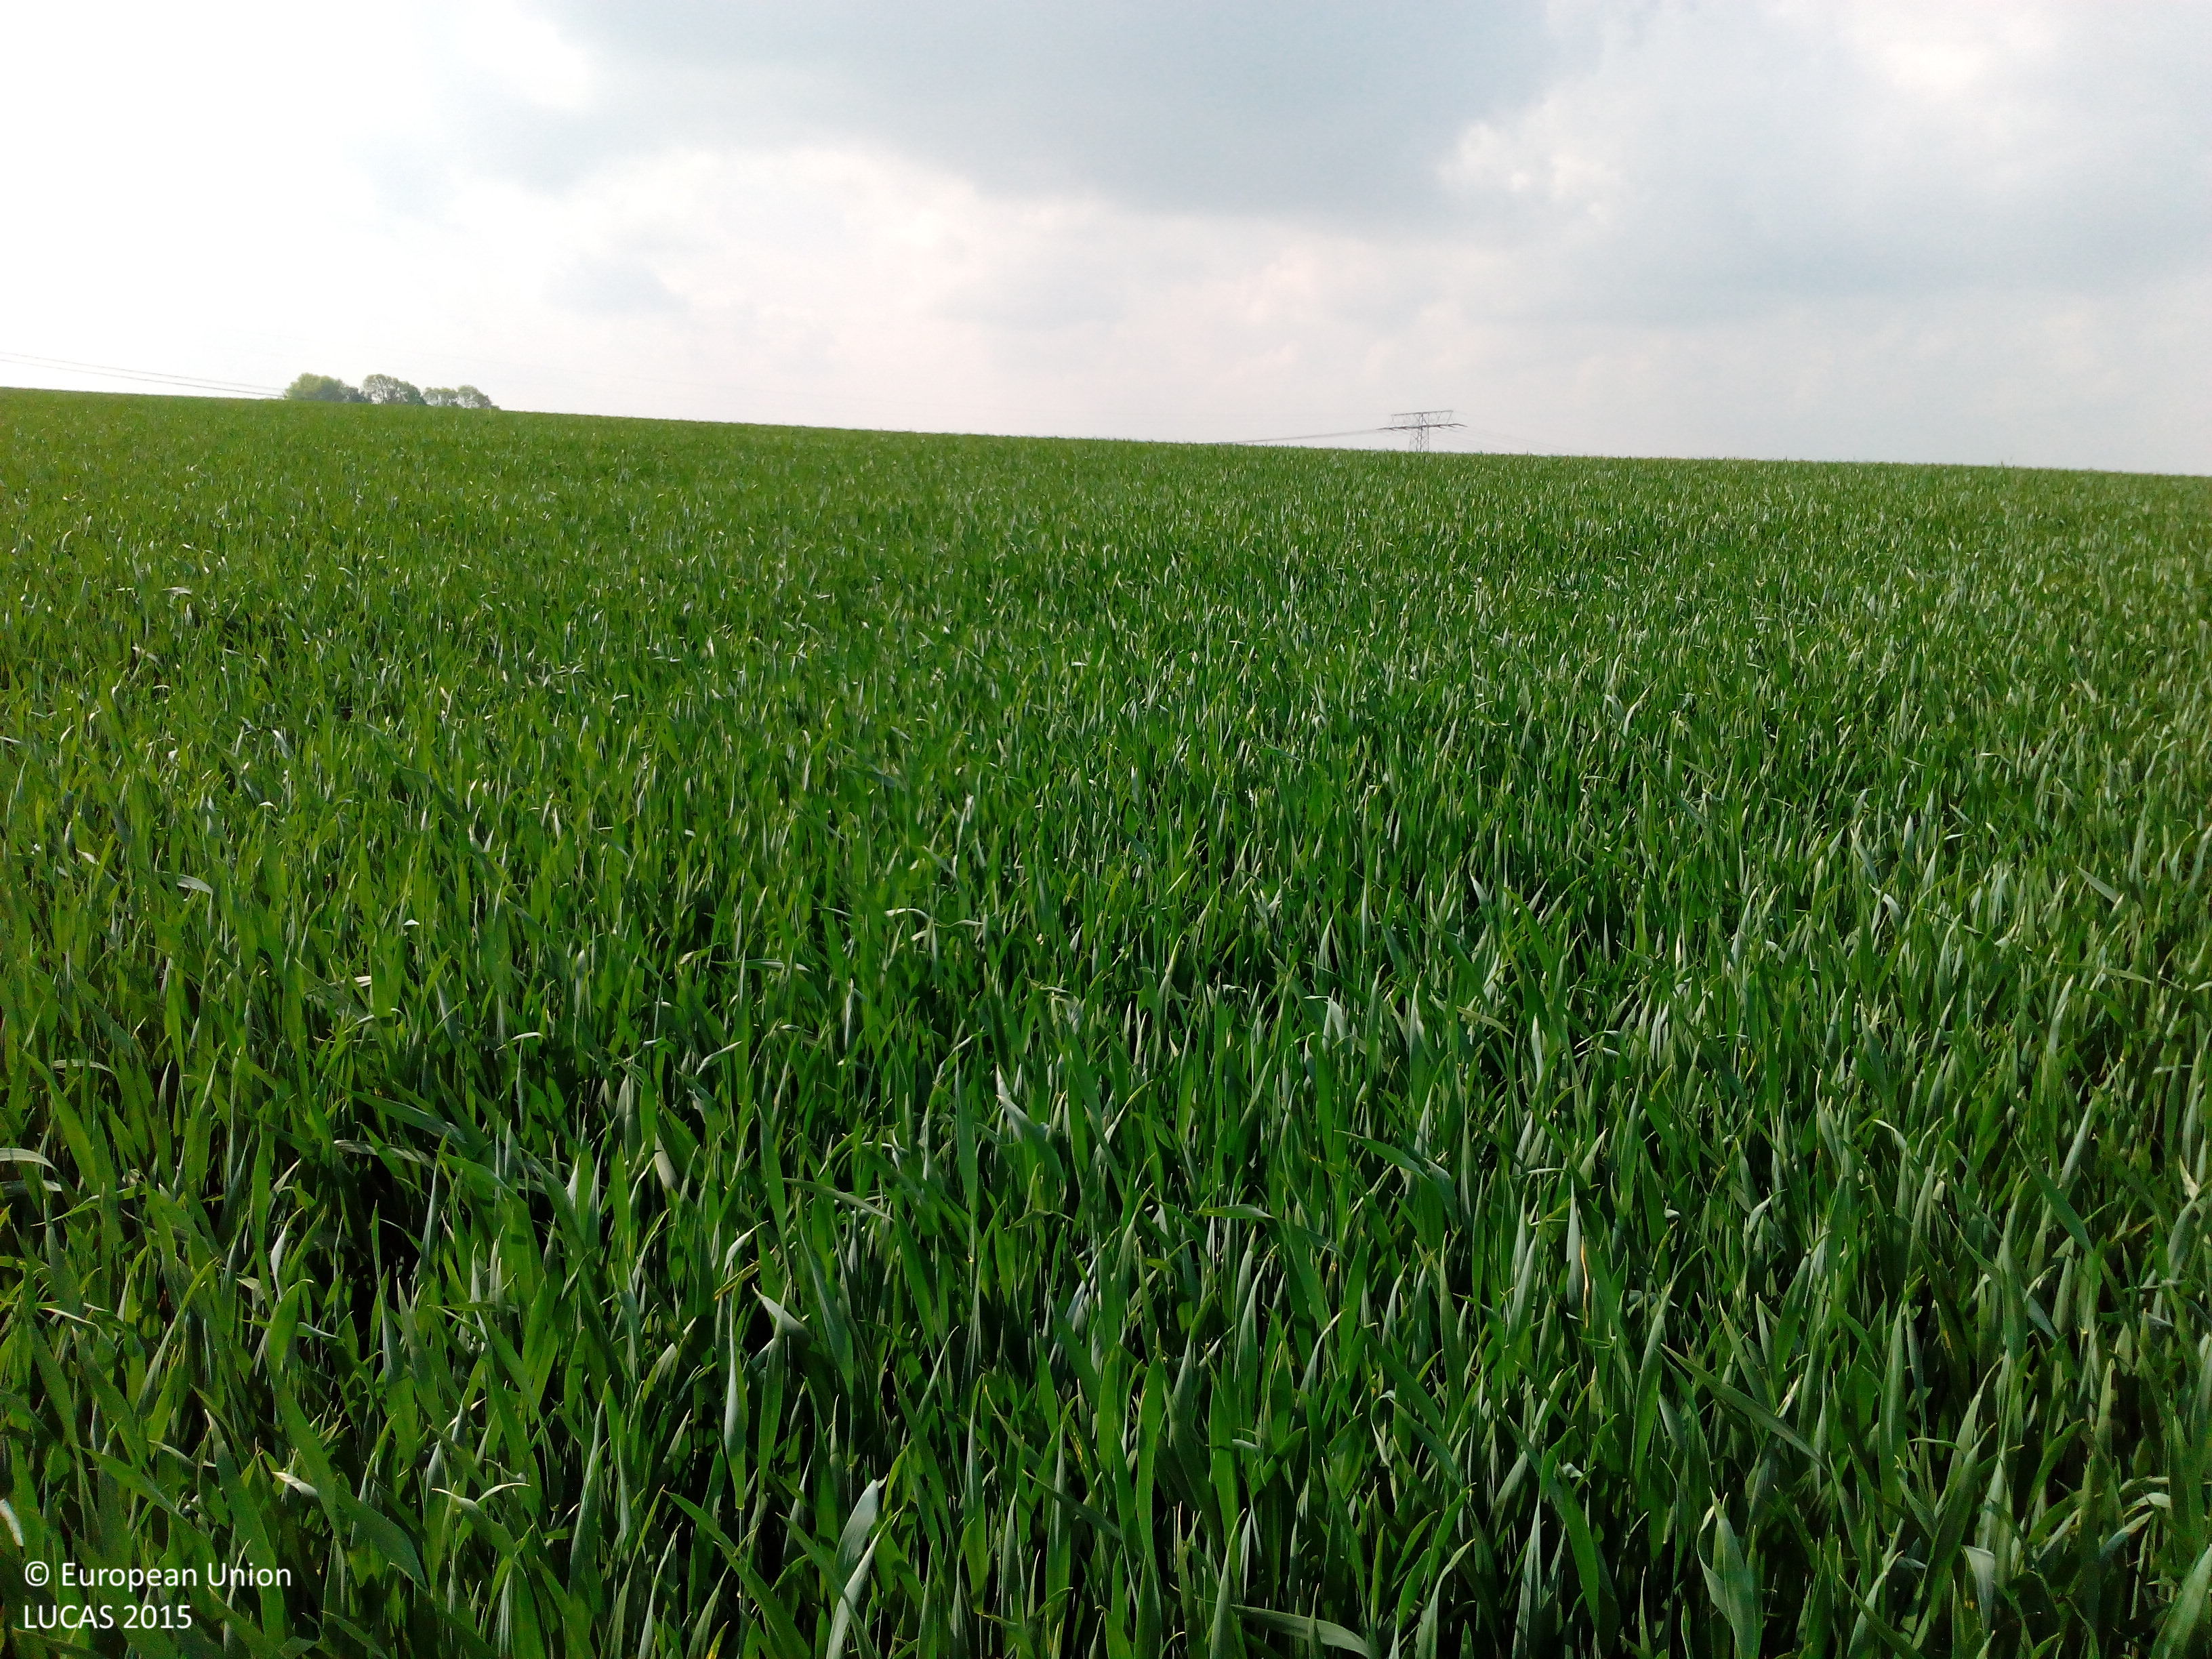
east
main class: Cropland
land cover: Common wheat
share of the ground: 50 - 75 %
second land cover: Barley
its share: 50 - 75 %
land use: Agriculture (excluding fallow land and kitchen gardens)
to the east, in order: Common wheat; Barley
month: May
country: DE
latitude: 51.0376
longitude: 11.4971
